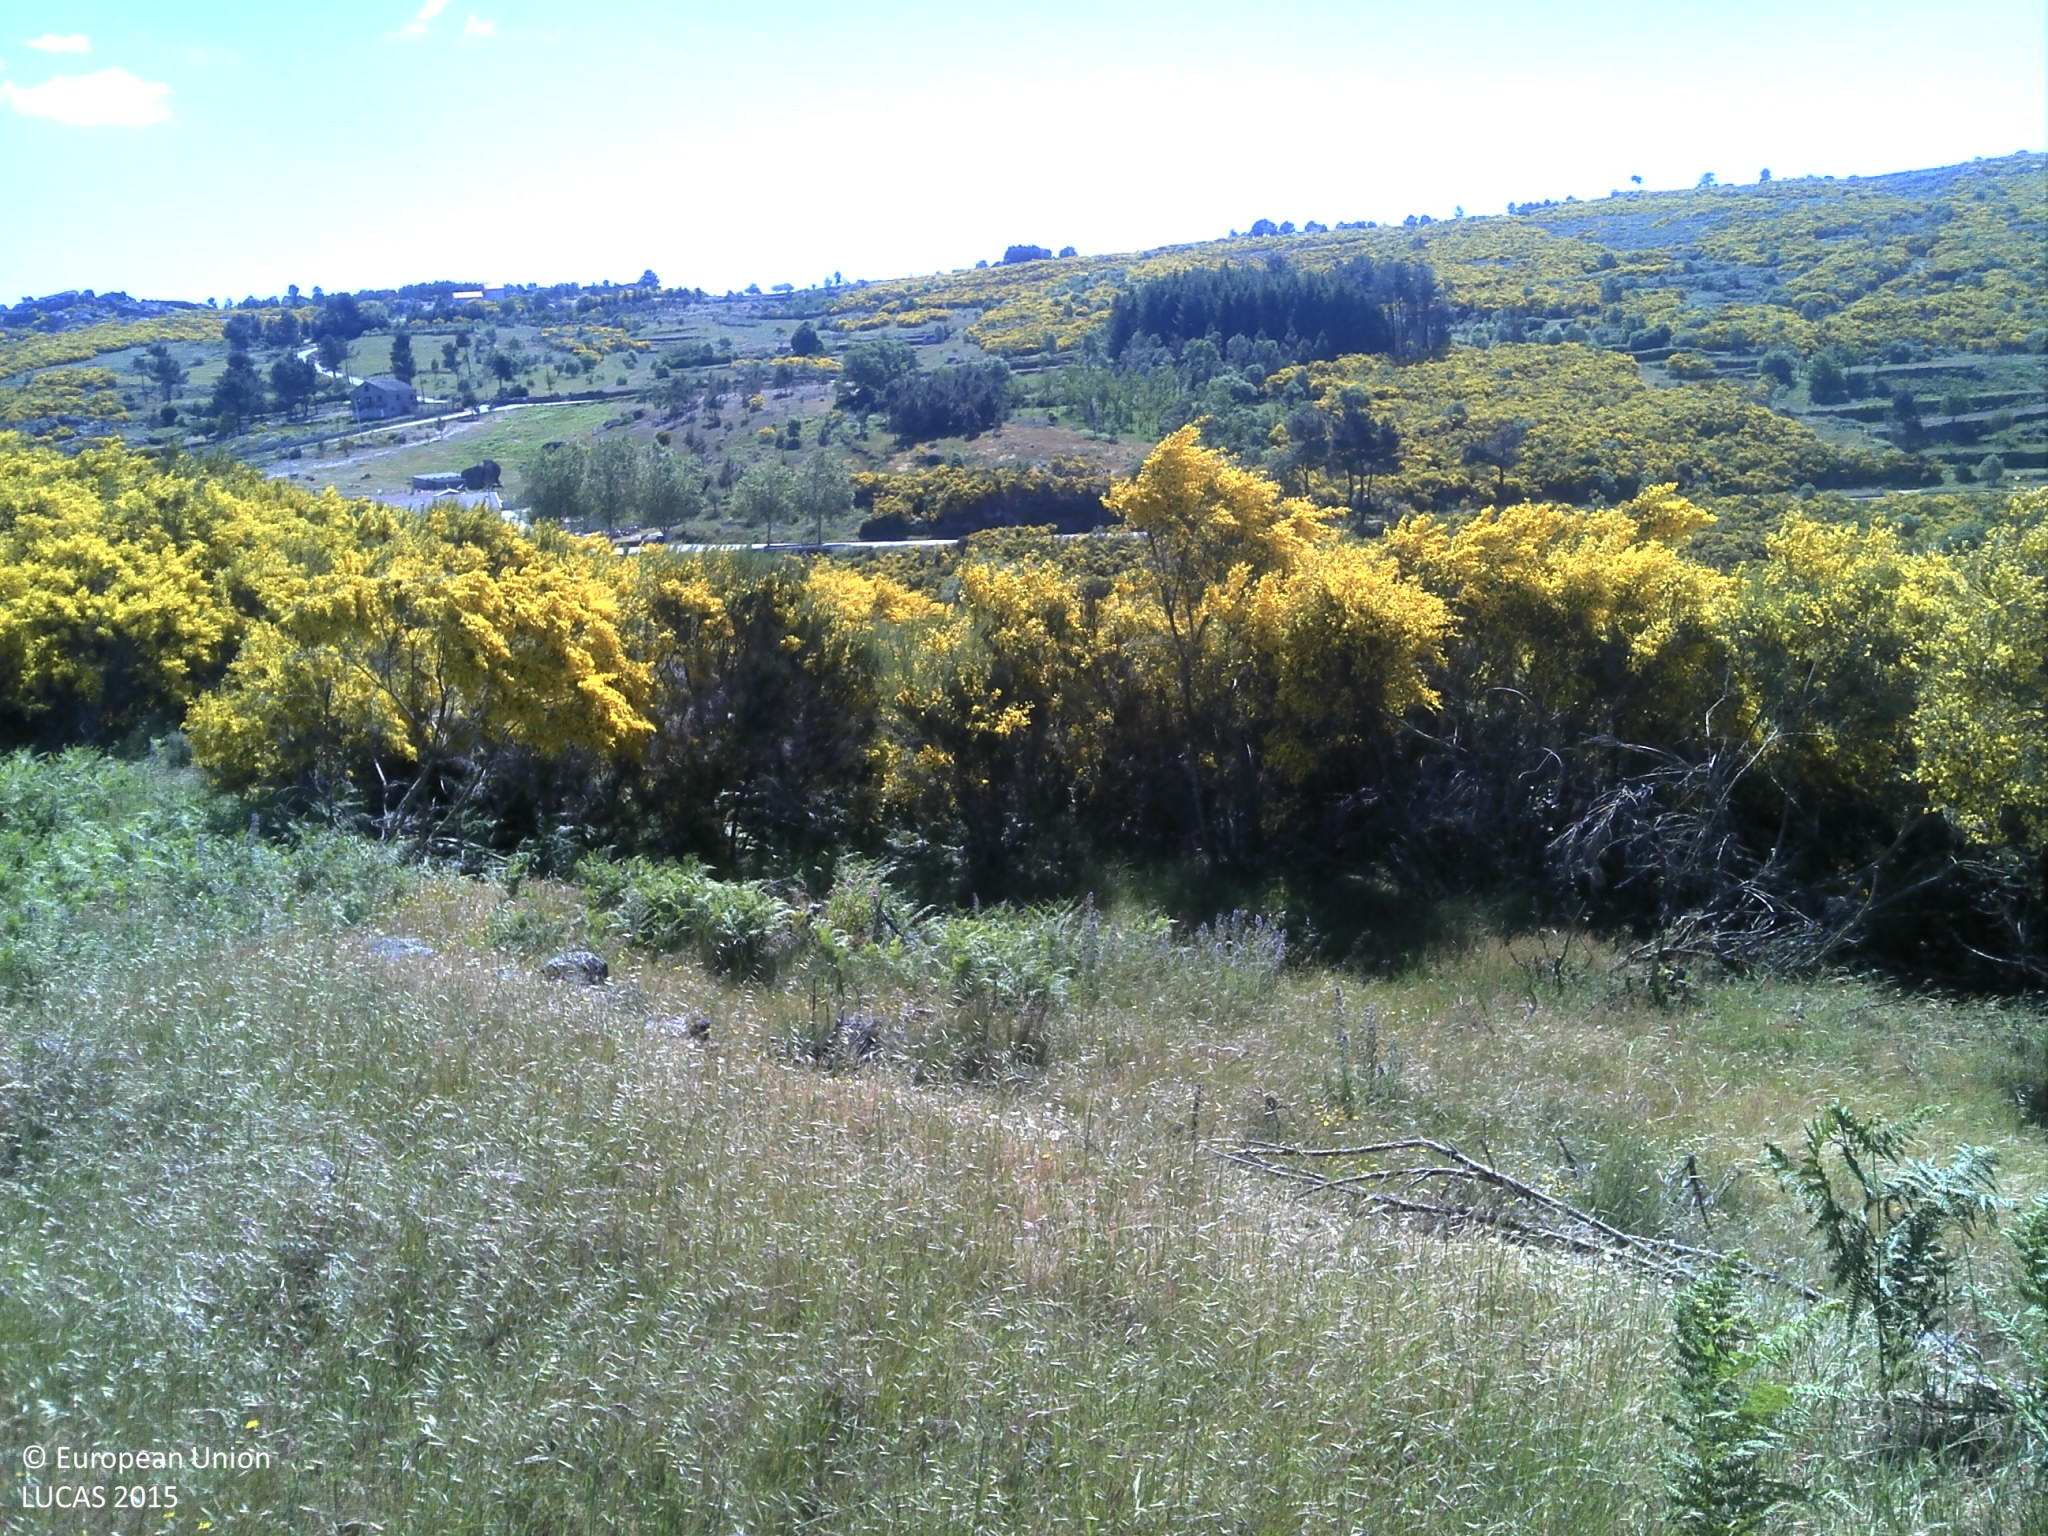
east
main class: Shrubland
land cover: Shrubland without tree cover
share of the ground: 50 - 75 %
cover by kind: shrubs 50 %, herbaceous plants 40 %, unconsolidated bare surface 10 %
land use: Semi-natural and natural areas not in use
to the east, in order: Shrubland without tree cover; Dry stone walls; Shrubland without tree cover; Rocks and stones; Shrubland without tree cover; Dry stone walls; Tracks; Dry stone walls; Grassland without tree/shrub cover
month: May
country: PT
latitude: 40.4933
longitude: -7.2722
